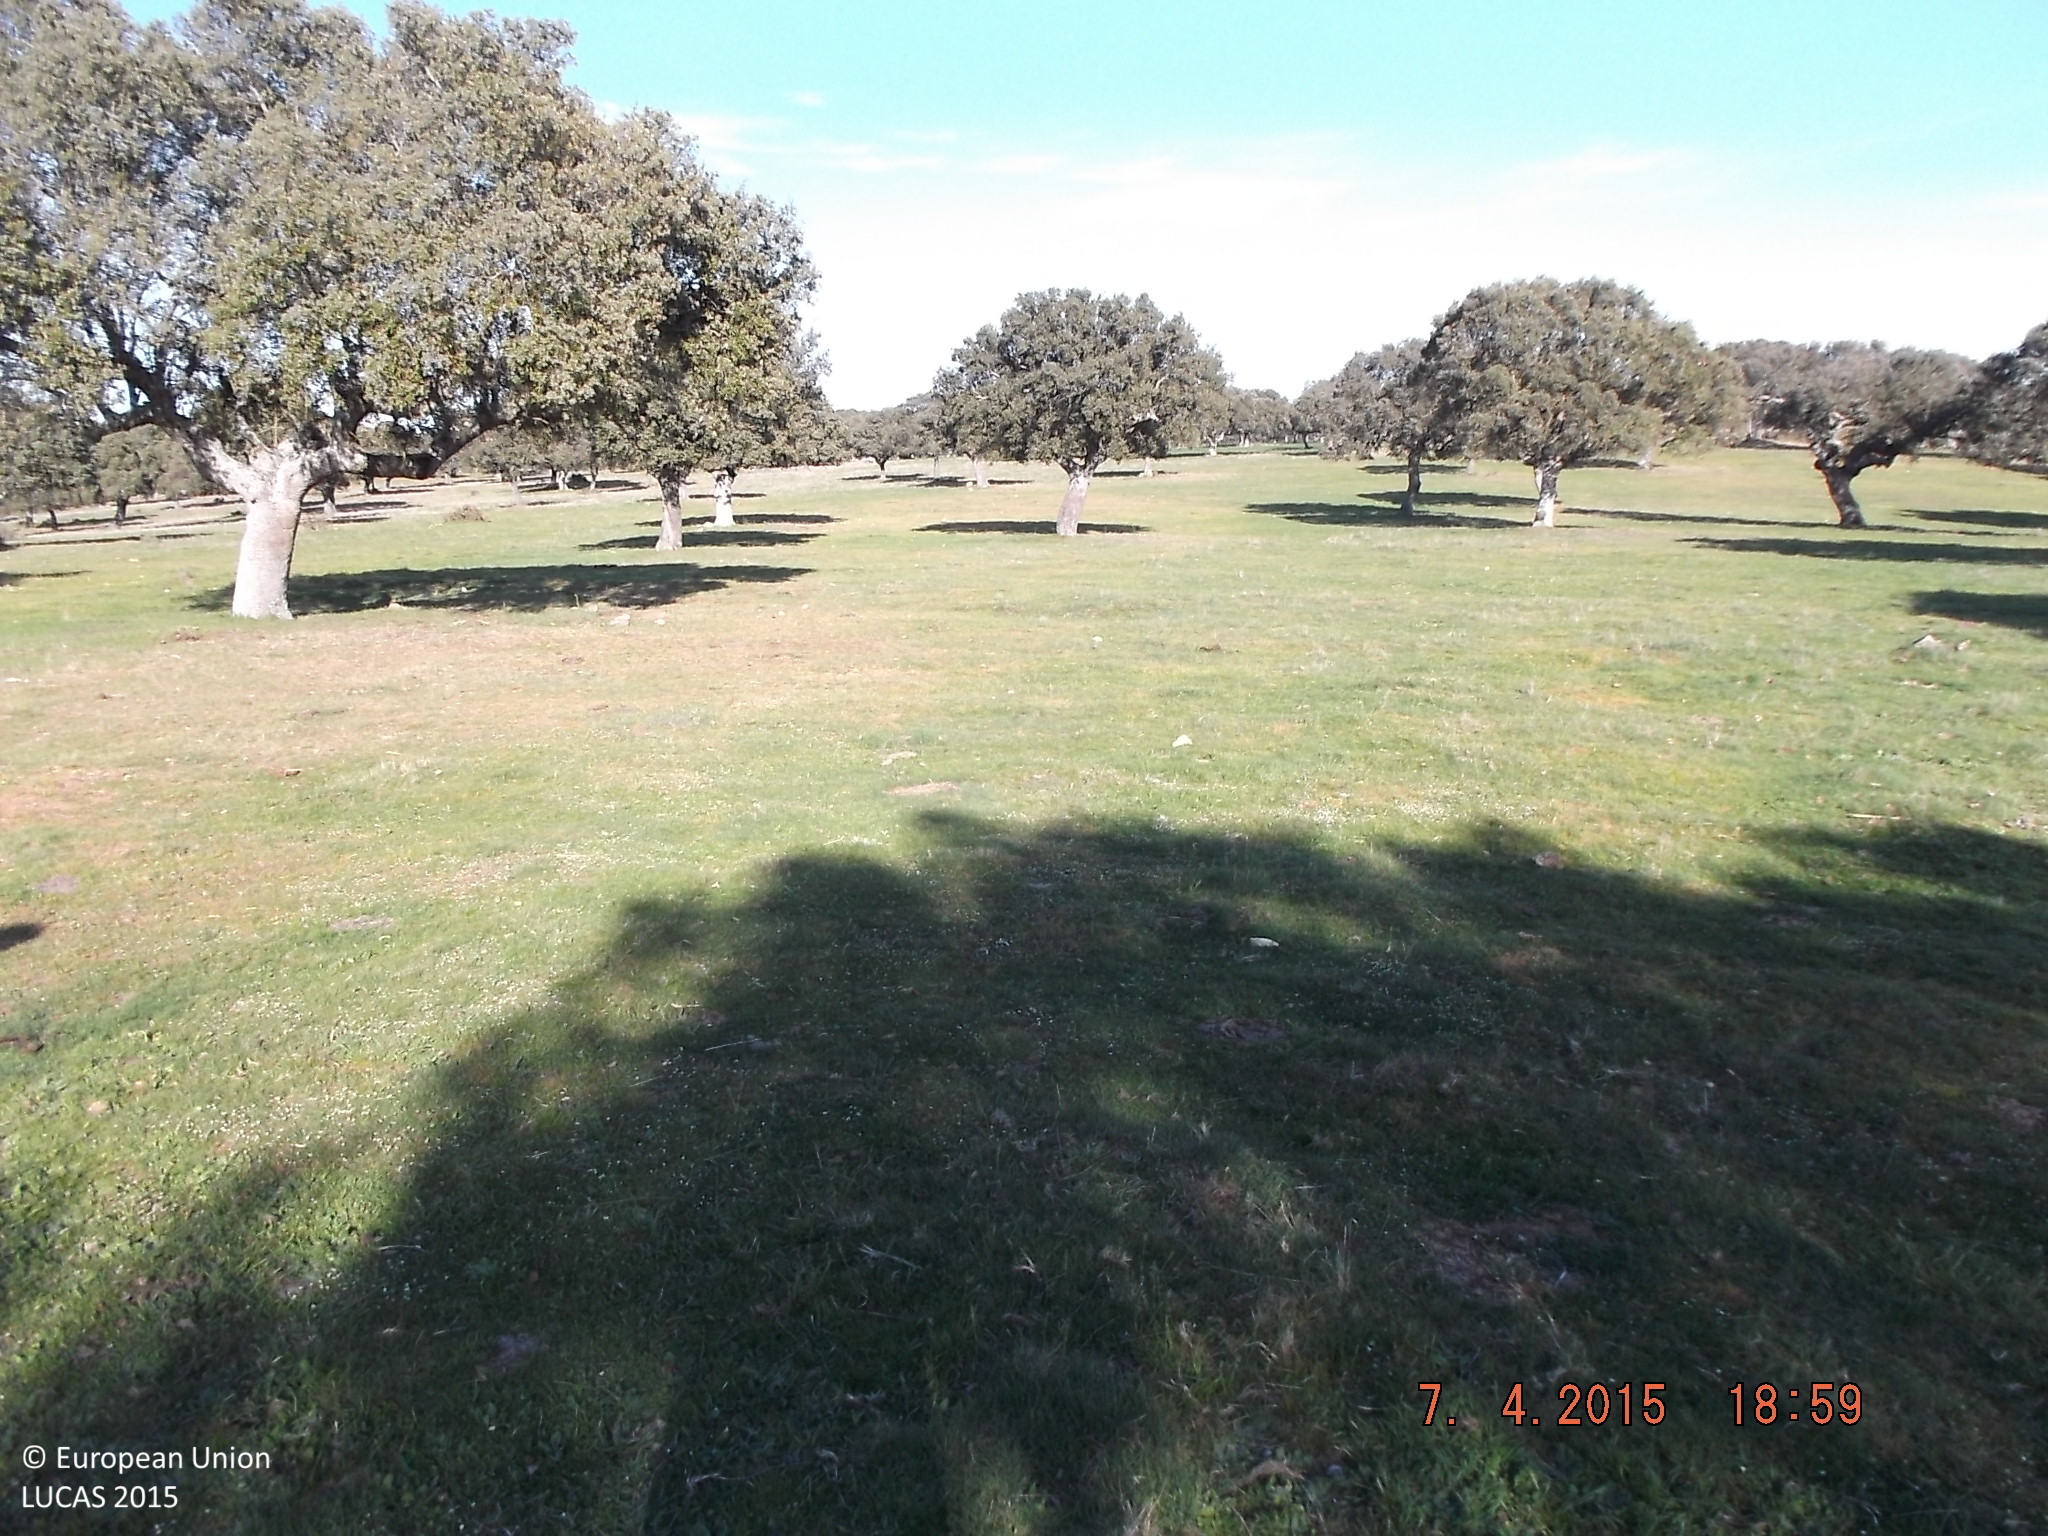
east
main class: Grassland
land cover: Grassland with sparse tree/shrub cover
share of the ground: > 75 %
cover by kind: herbaceous plants 90 %, broadleaved forest trees 5 %, shrubs 5 %
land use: Agriculture (excluding fallow land and kitchen gardens)
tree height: > 5 m
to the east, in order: Grassland with sparse tree/shrub cover; Broadleaved woodland; Grassland with sparse tree/shrub cover
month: April
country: ES
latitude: 40.7787
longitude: -5.9217
